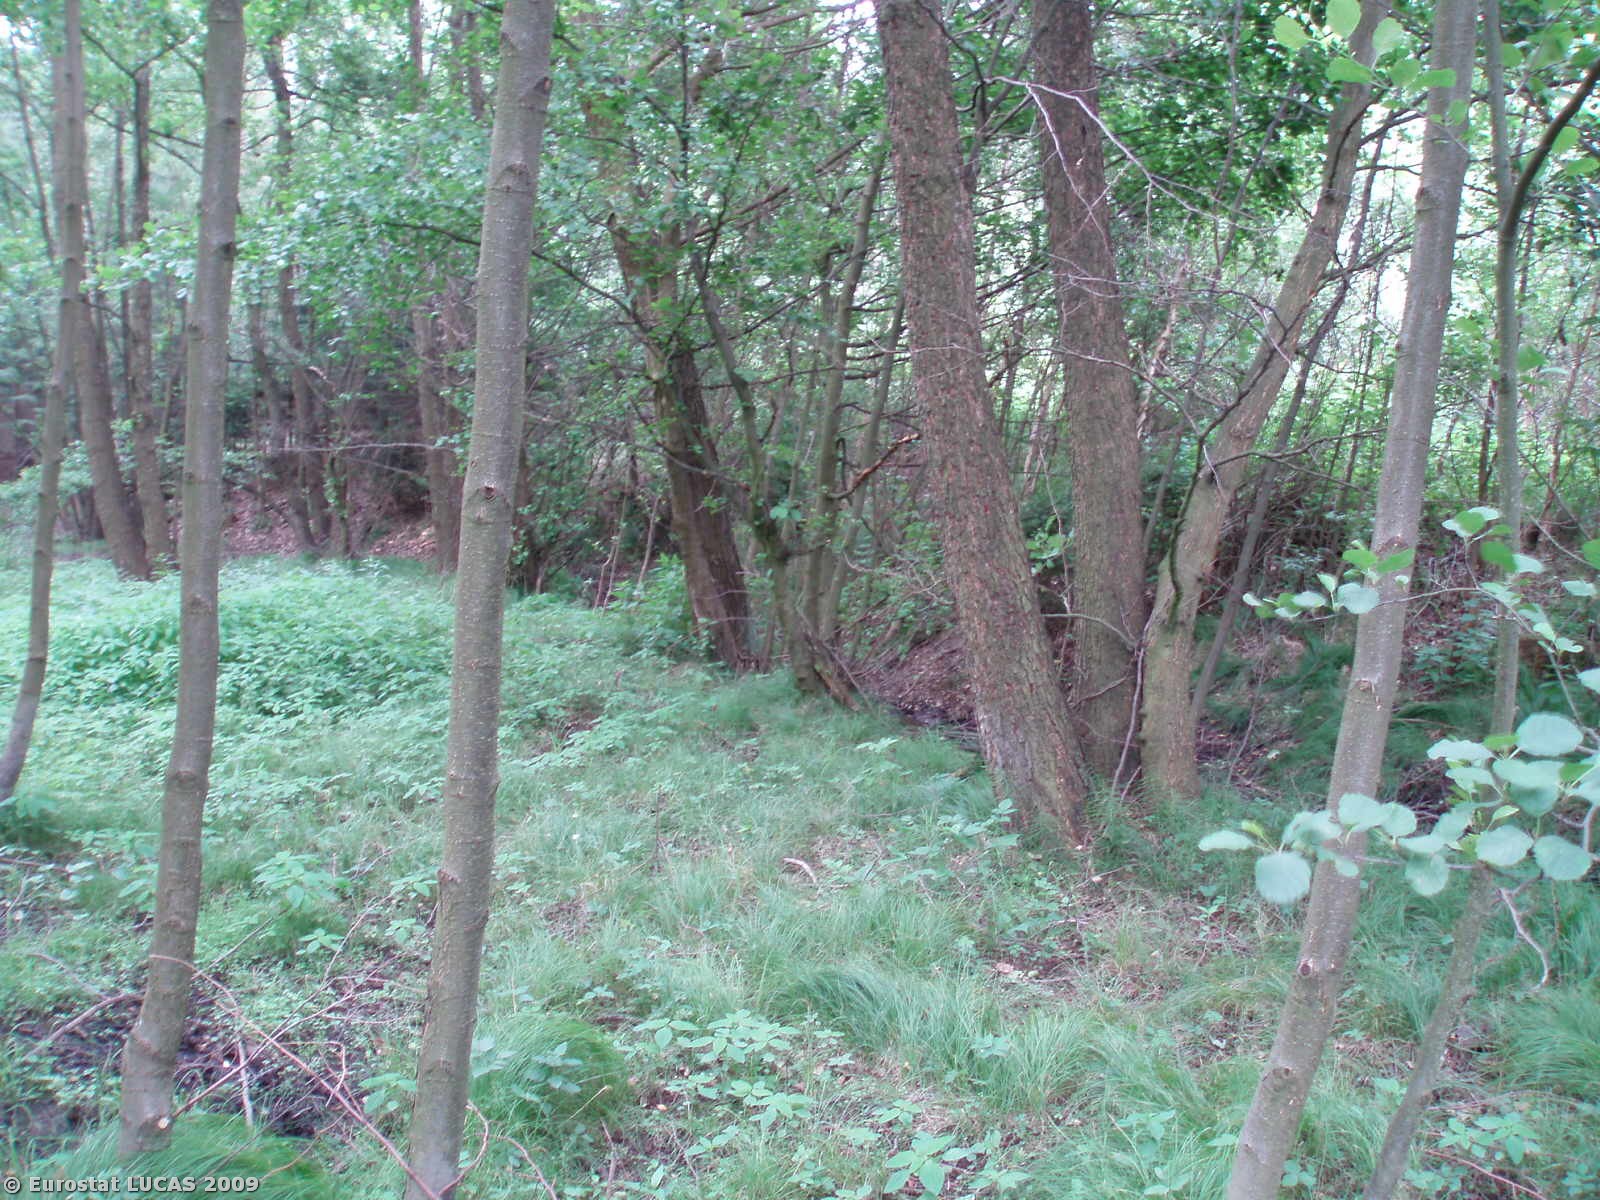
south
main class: Woodland
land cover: Broadleaved woodland
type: non-riverine alder, birch or aspen forest
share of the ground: > 75 %
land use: Forestry
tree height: > 5 m
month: June
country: CZ
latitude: 49.8363
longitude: 14.2140
